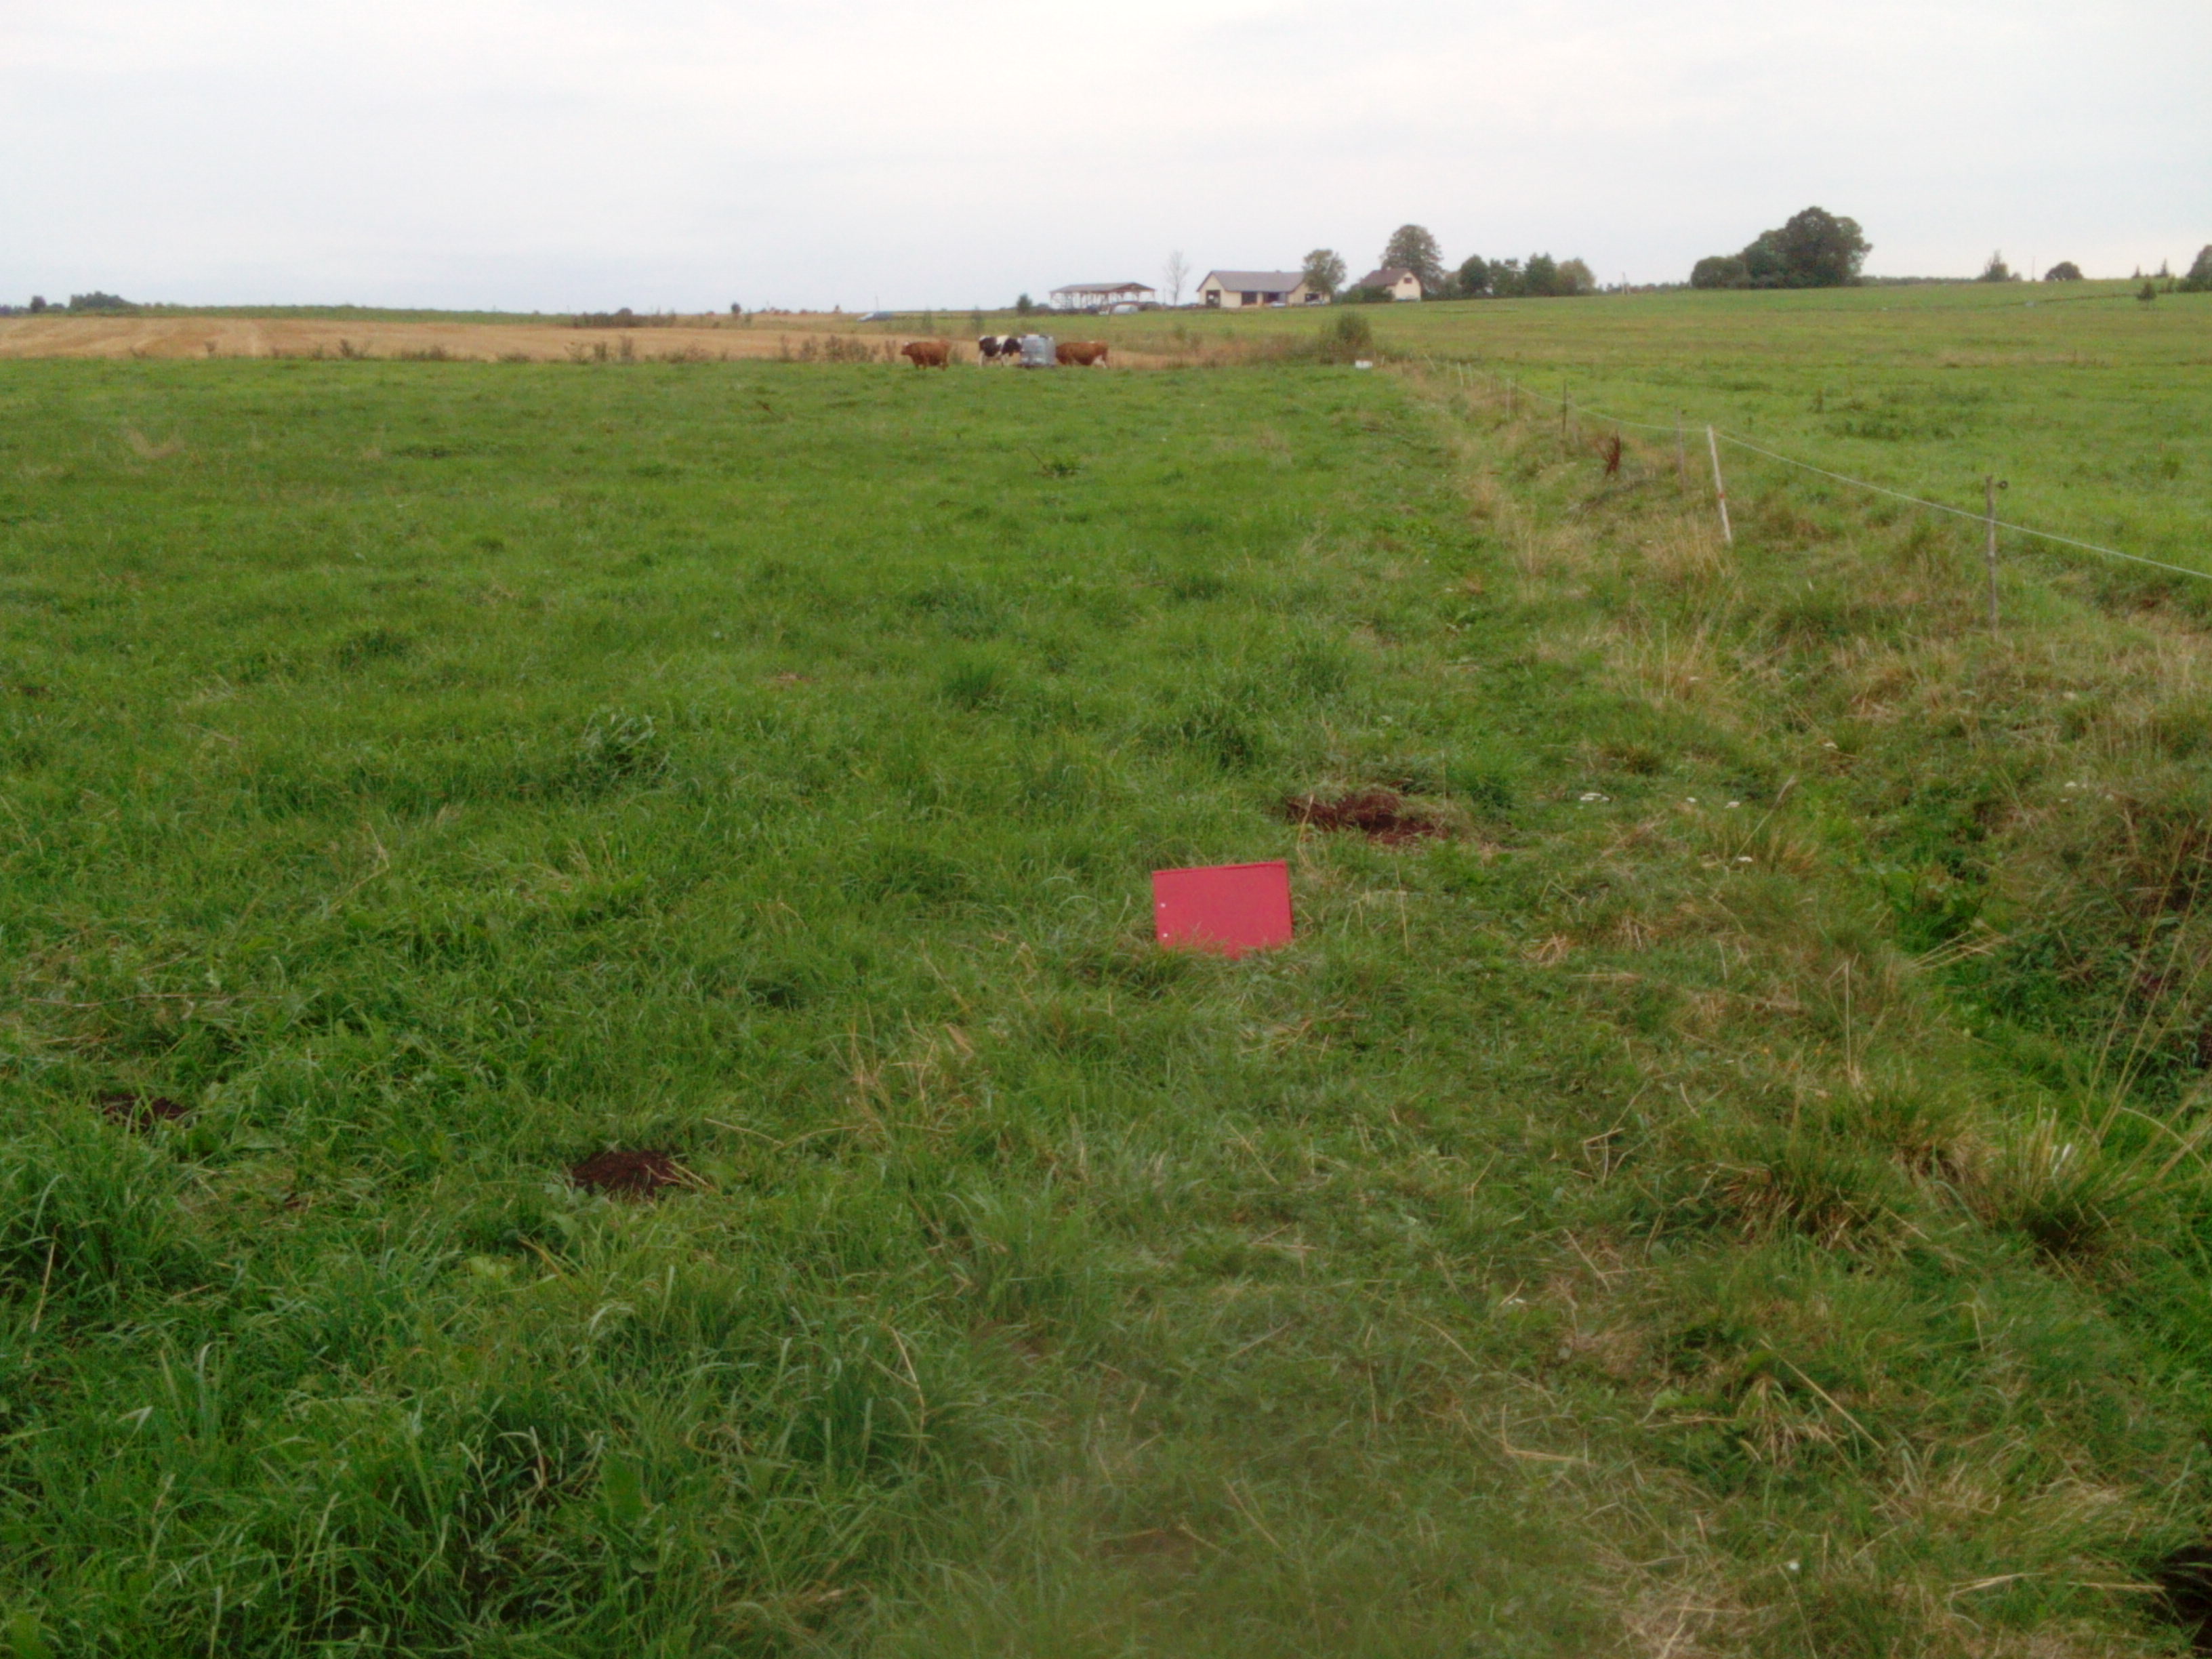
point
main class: Grassland
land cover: Grassland without tree/shrub cover
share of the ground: > 75 %
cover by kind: herbaceous plants 100 %
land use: Agriculture (excluding fallow land and kitchen gardens)
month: September
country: LT
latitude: 55.7767
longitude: 22.8360
